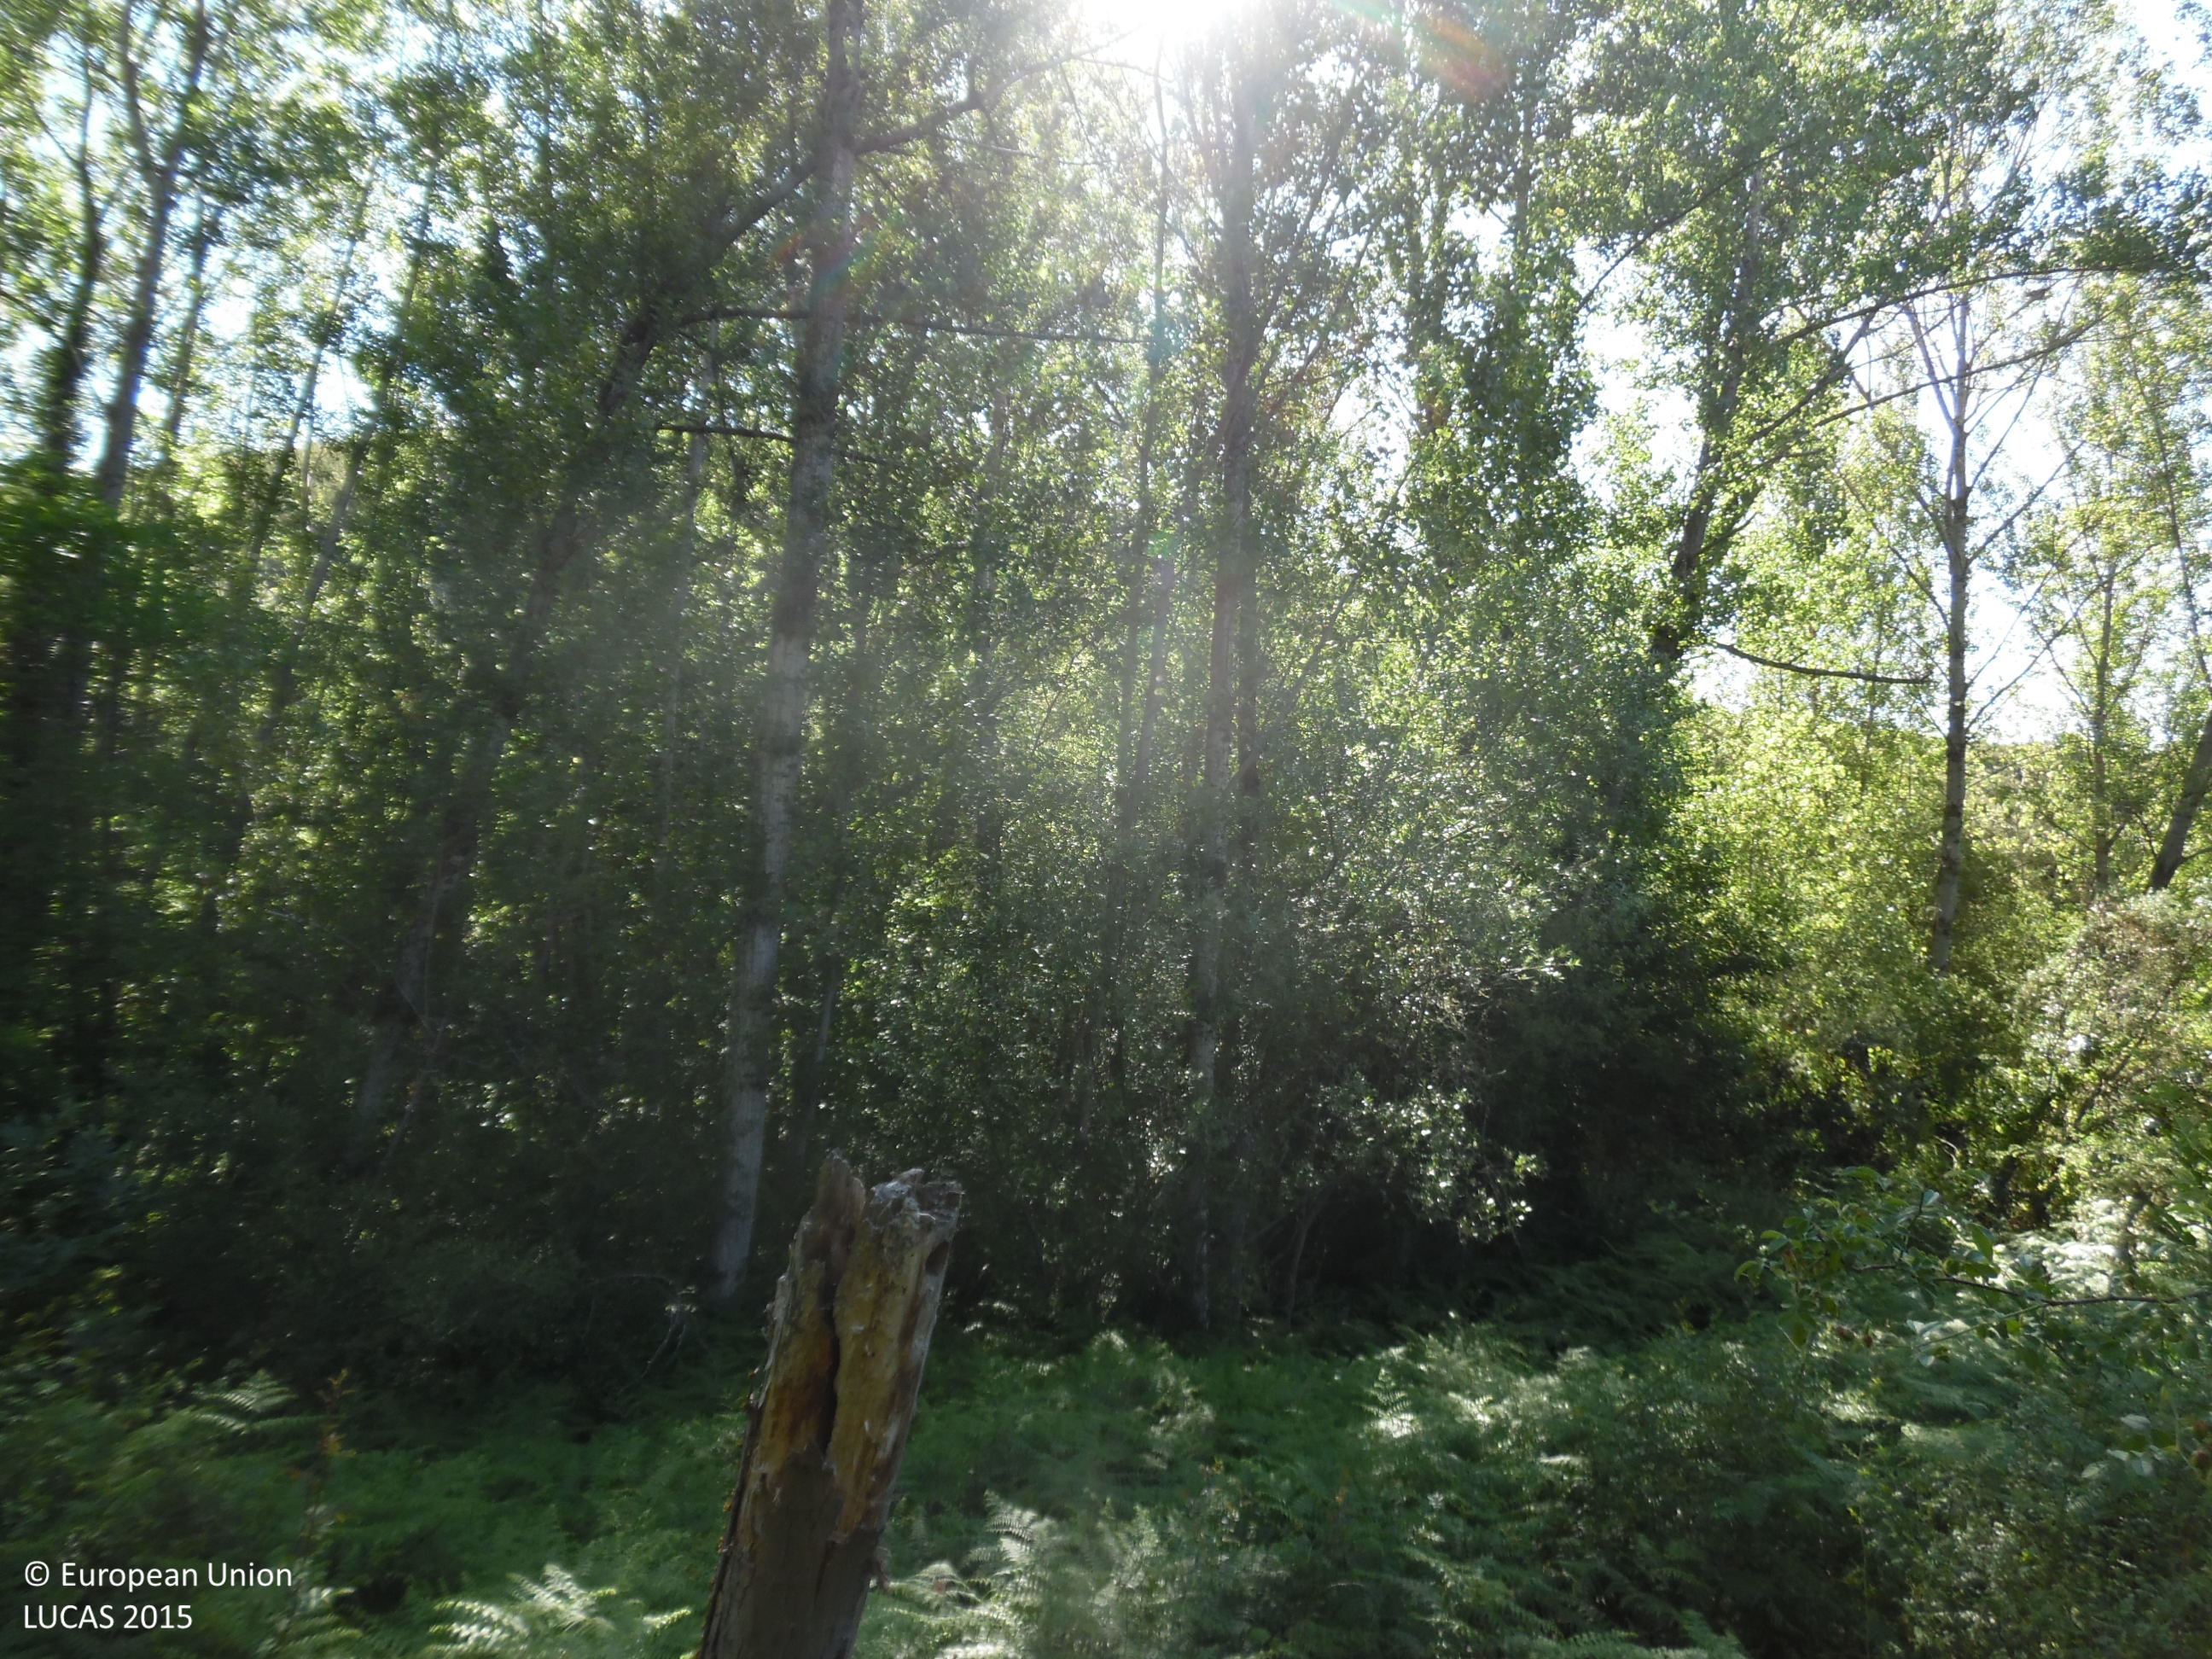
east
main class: Woodland
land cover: Broadleaved woodland
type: thermophilous deciduous forest
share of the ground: > 75 %
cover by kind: broadleaved forest trees 95 %, shrubs 5 %
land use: Forestry
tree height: > 5 m
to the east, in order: Broadleaved woodland; Rivers and streams; Broadleaved woodland; Tracks; Broadleaved woodland; Shrubland with sparse tree cover; Shrubland without tree cover; Tracks; Shrubland without tree cover; Grassland with sparse tree/shrub cover
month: June
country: ES
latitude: 42.6247
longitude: -6.7680
